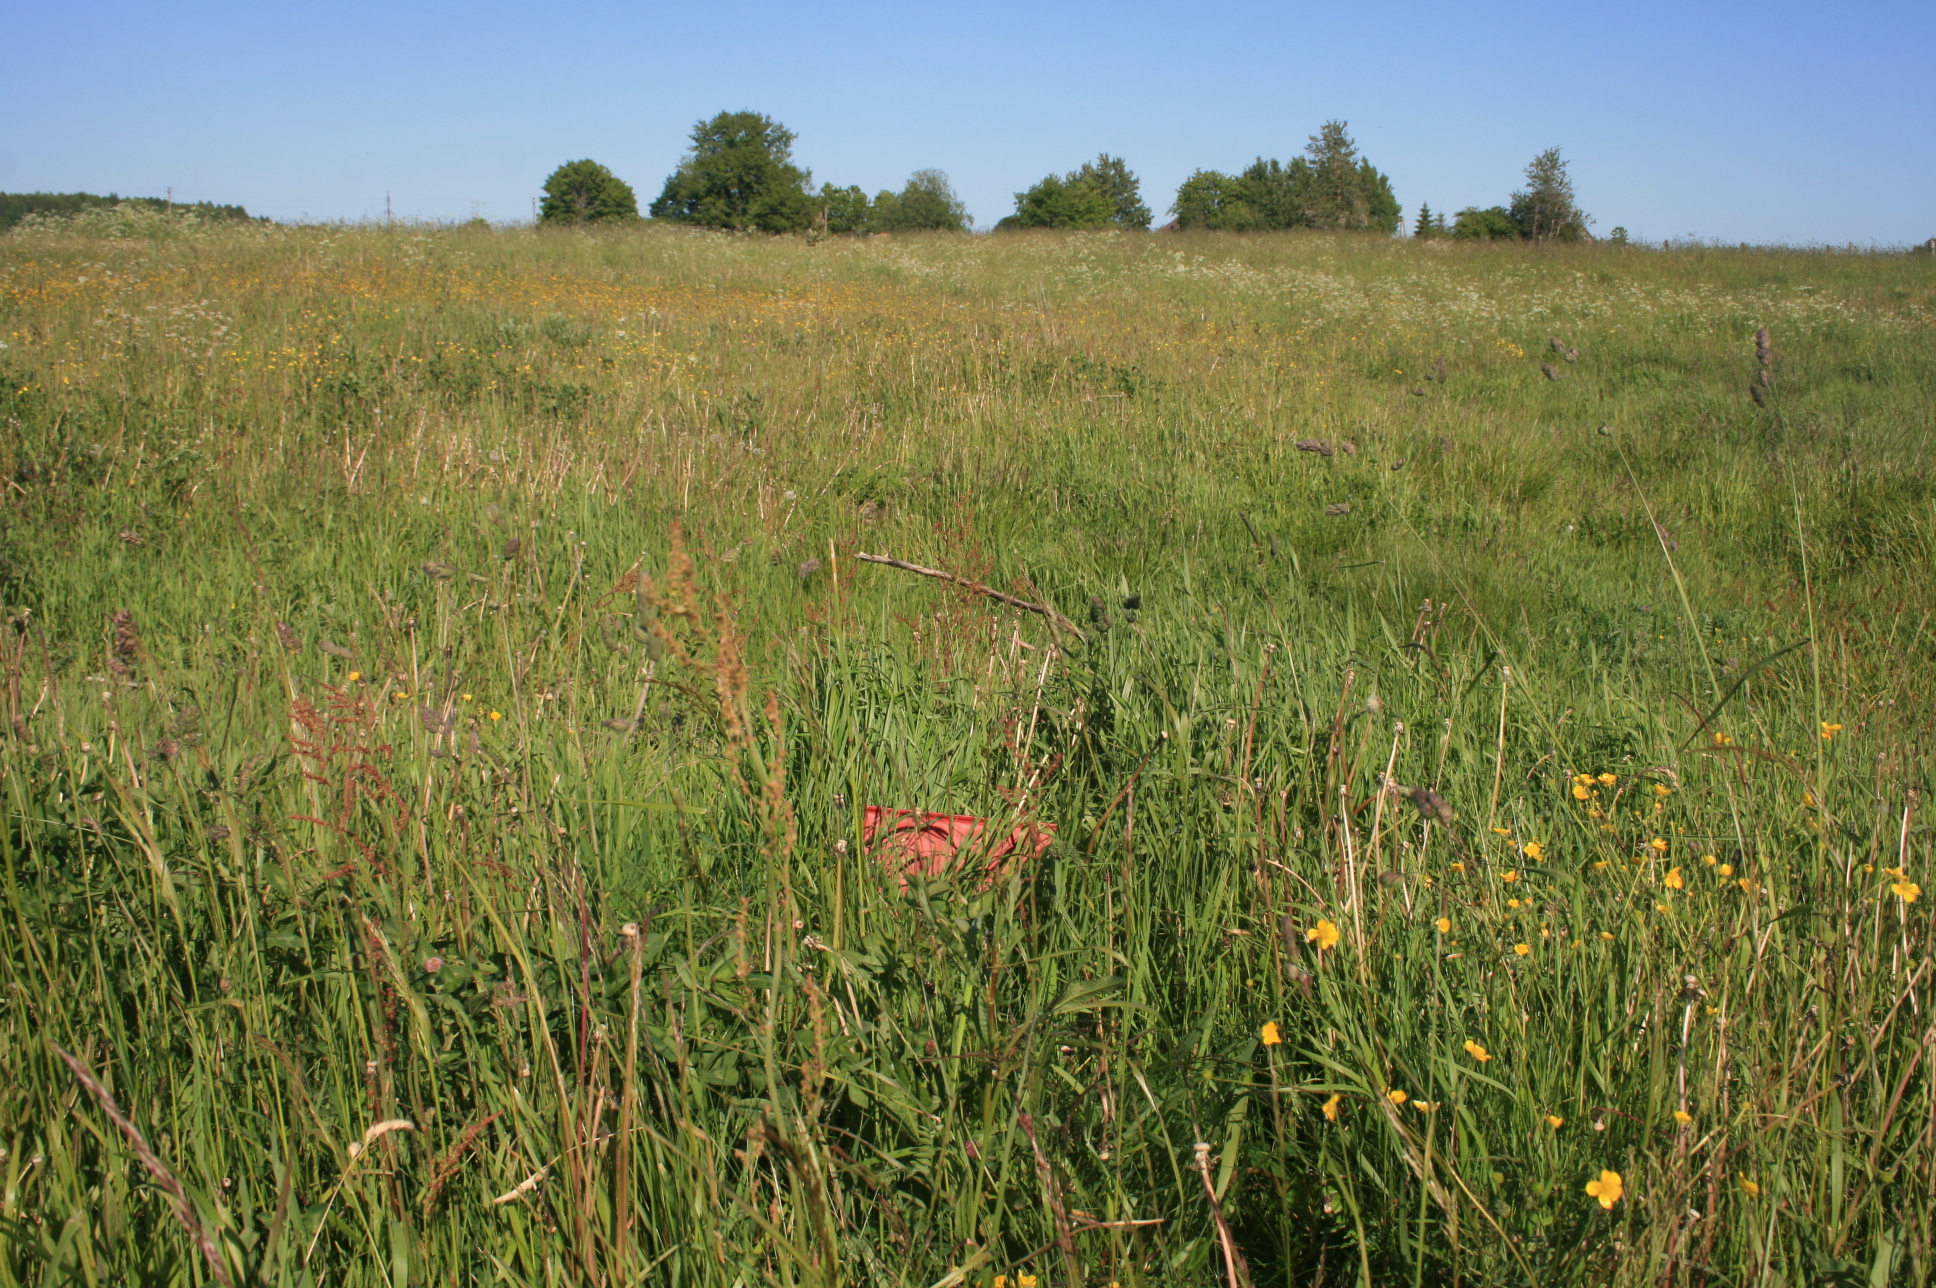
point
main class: Grassland
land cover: Grassland without tree/shrub cover
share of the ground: > 75 %
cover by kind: herbaceous plants 100 %
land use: Agriculture (excluding fallow land and kitchen gardens)
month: June
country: LT
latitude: 55.5471
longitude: 22.2129
